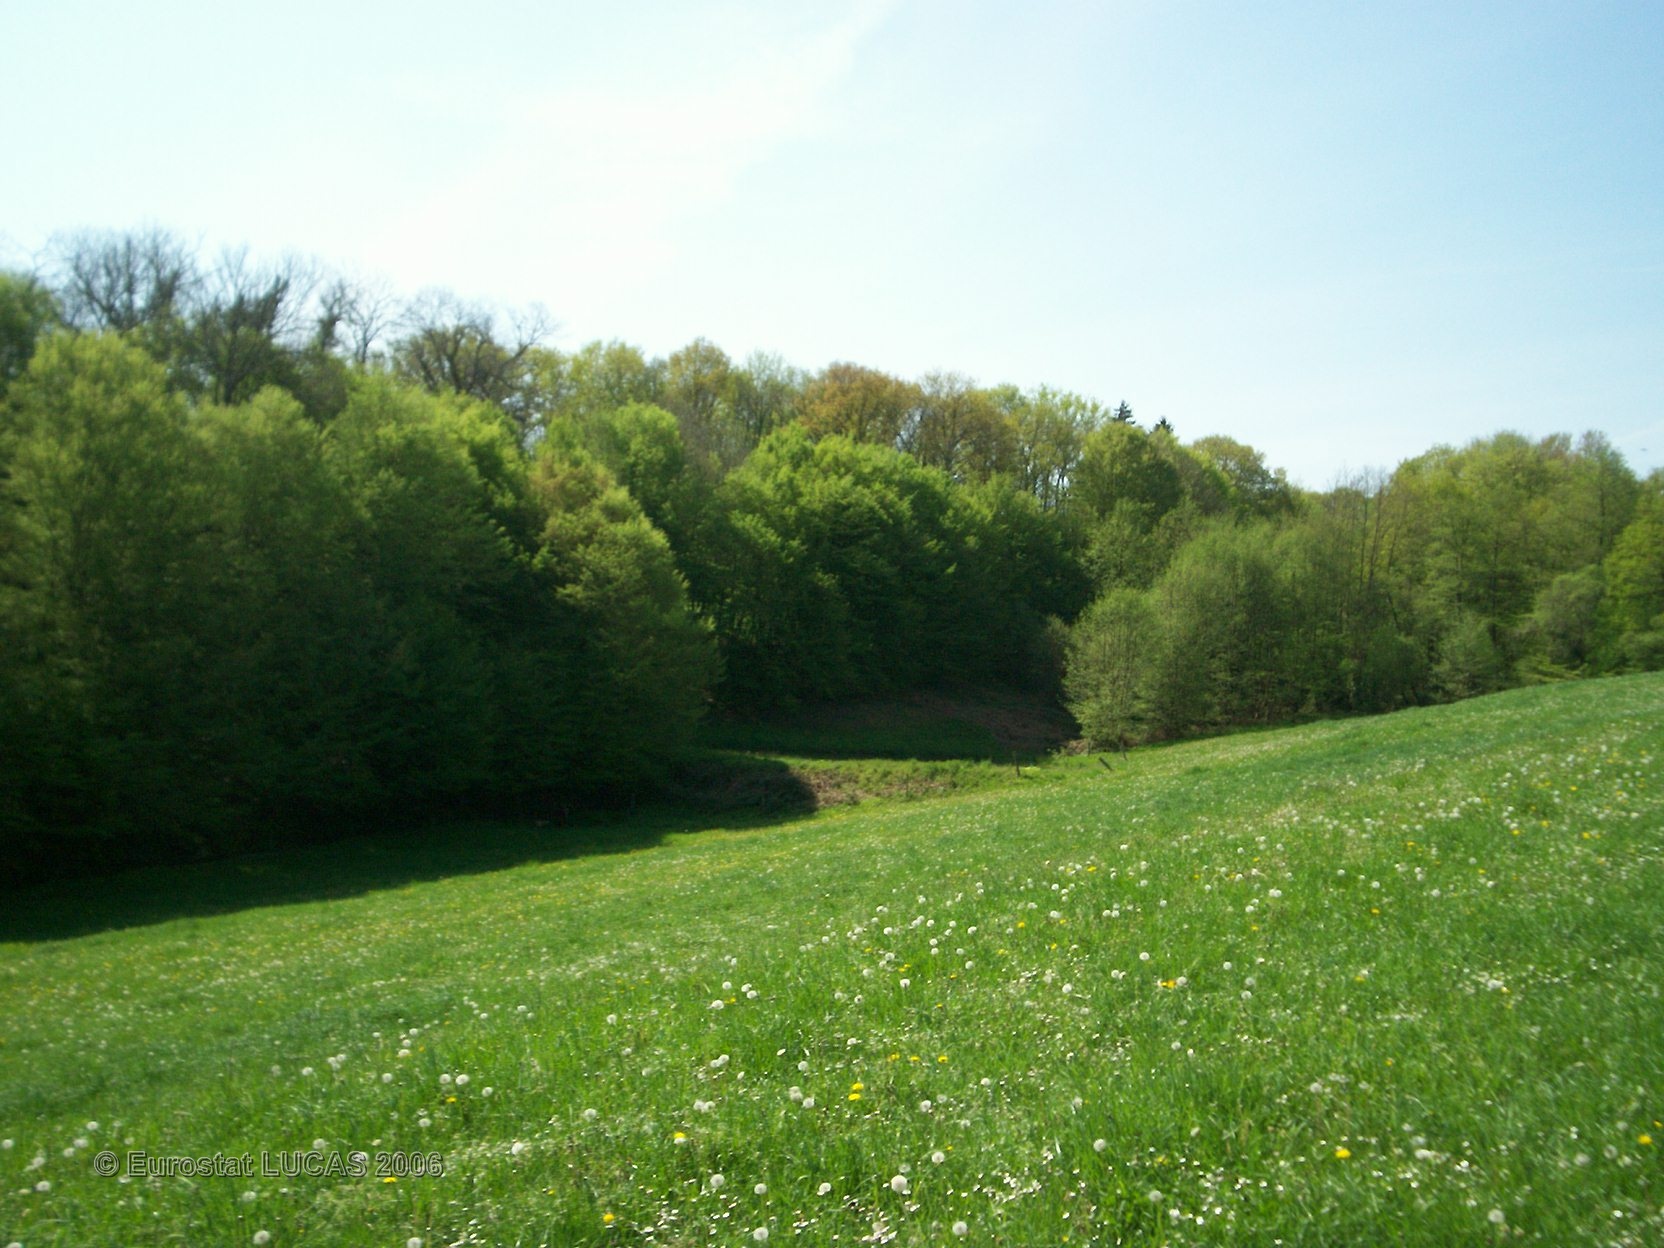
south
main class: Grassland
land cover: Grassland without tree/shrub cover
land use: Agriculture (excluding fallow land and kitchen gardens)
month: May
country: FR
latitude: 46.3848
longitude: 1.6301
